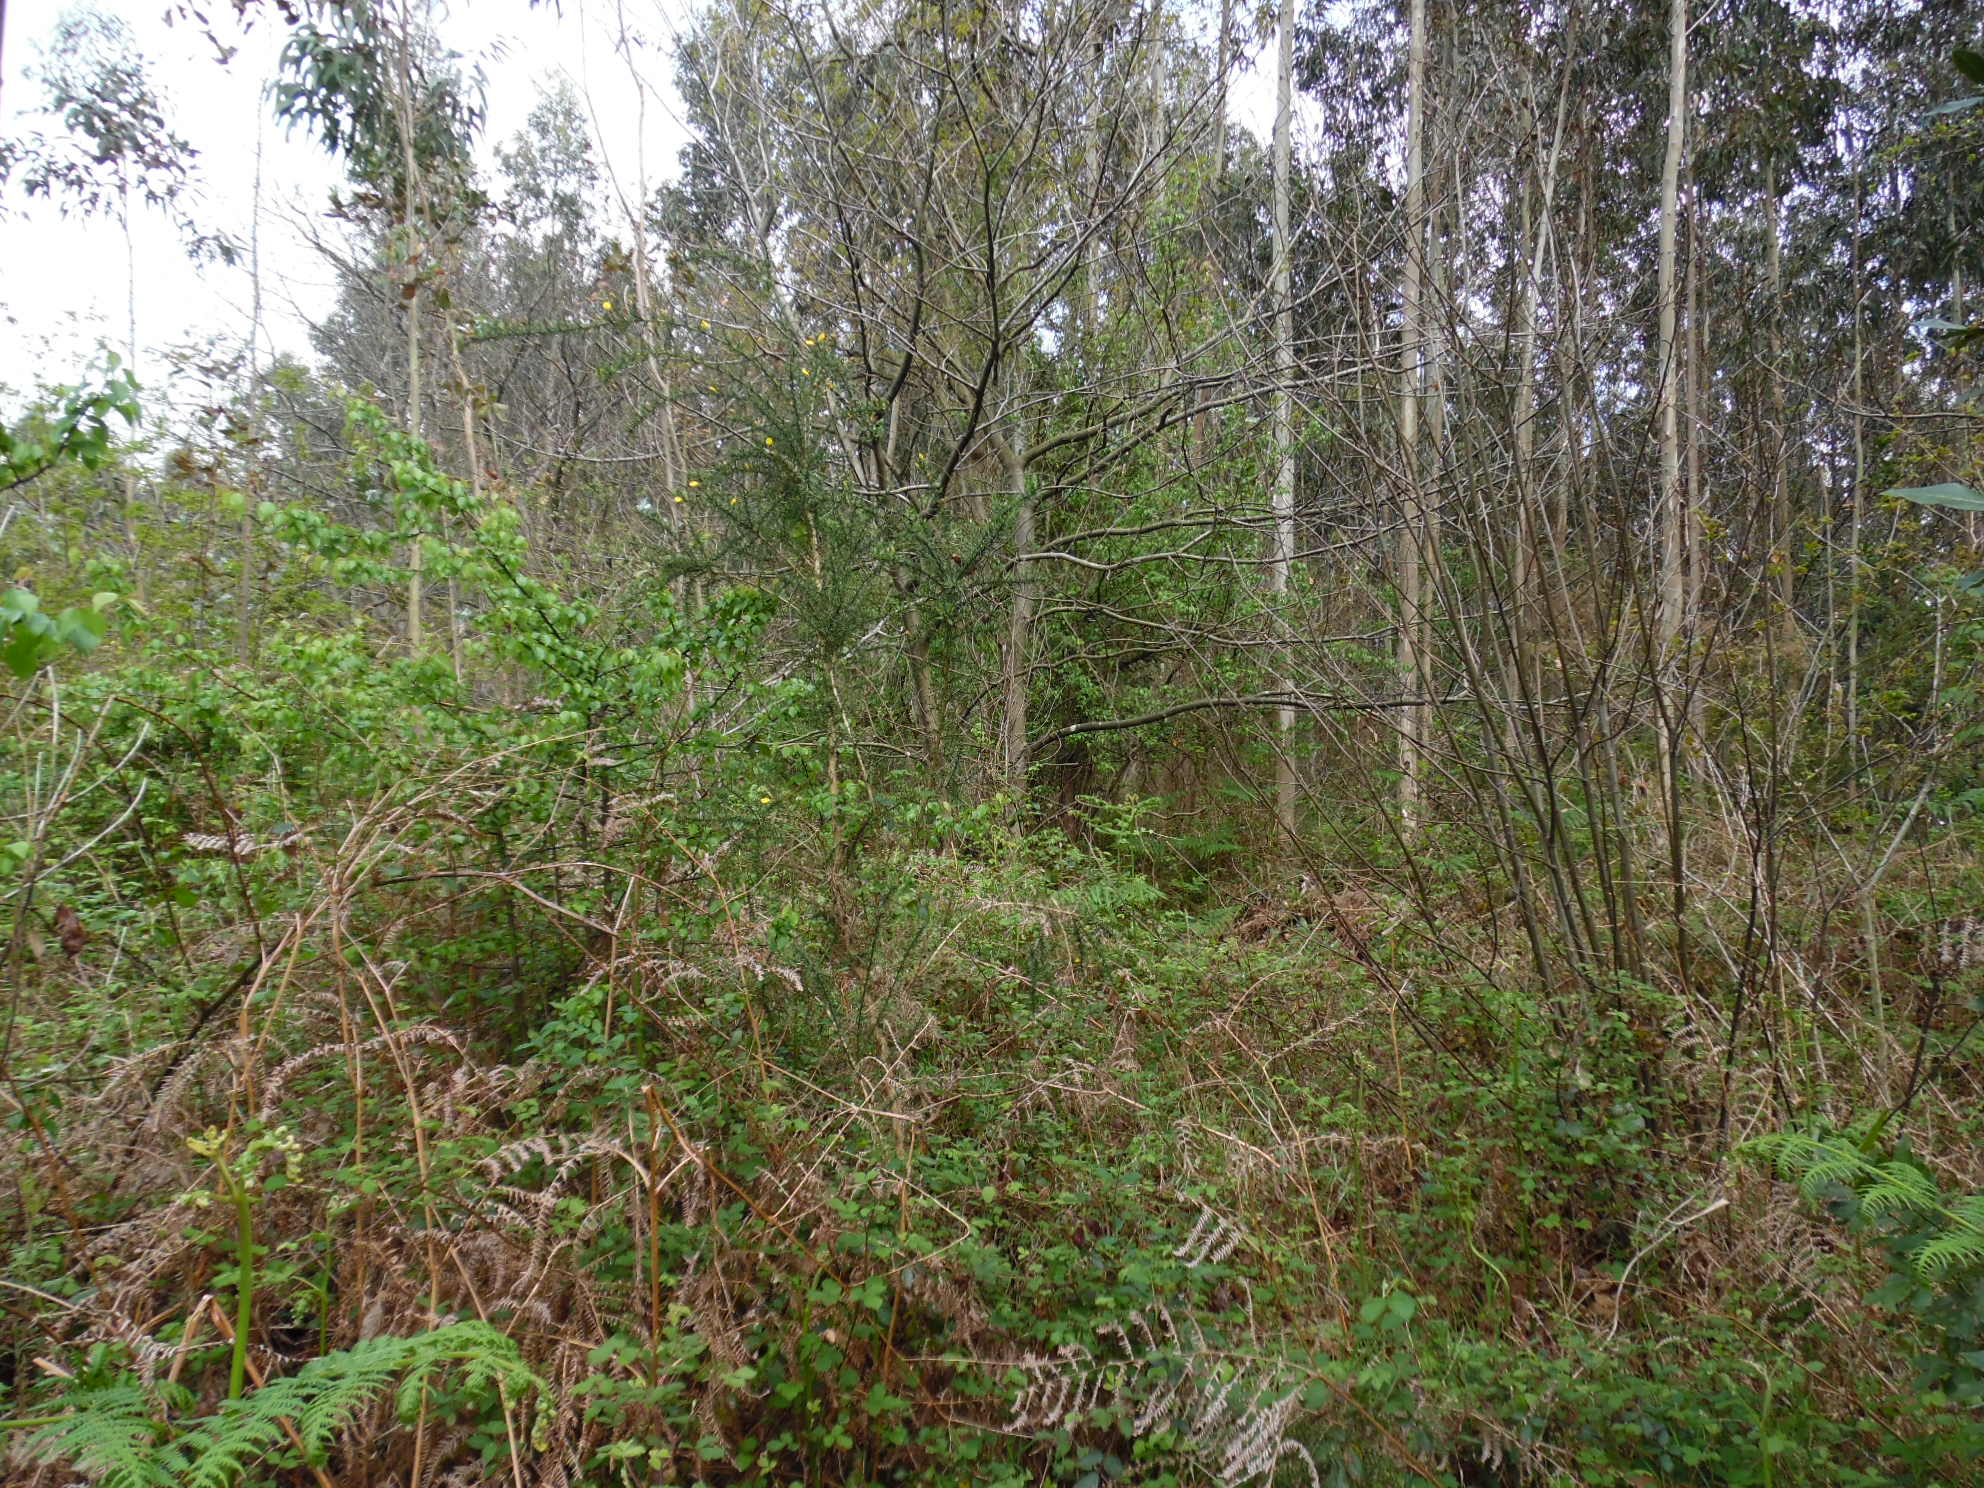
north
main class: Woodland
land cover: Broadleaved woodland
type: exotic forest
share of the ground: > 75 %
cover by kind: broadleaved forest trees 95 %, shrubs 5 %
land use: Forestry
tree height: > 5 m
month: April
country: ES
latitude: 43.5597
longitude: -5.8746
